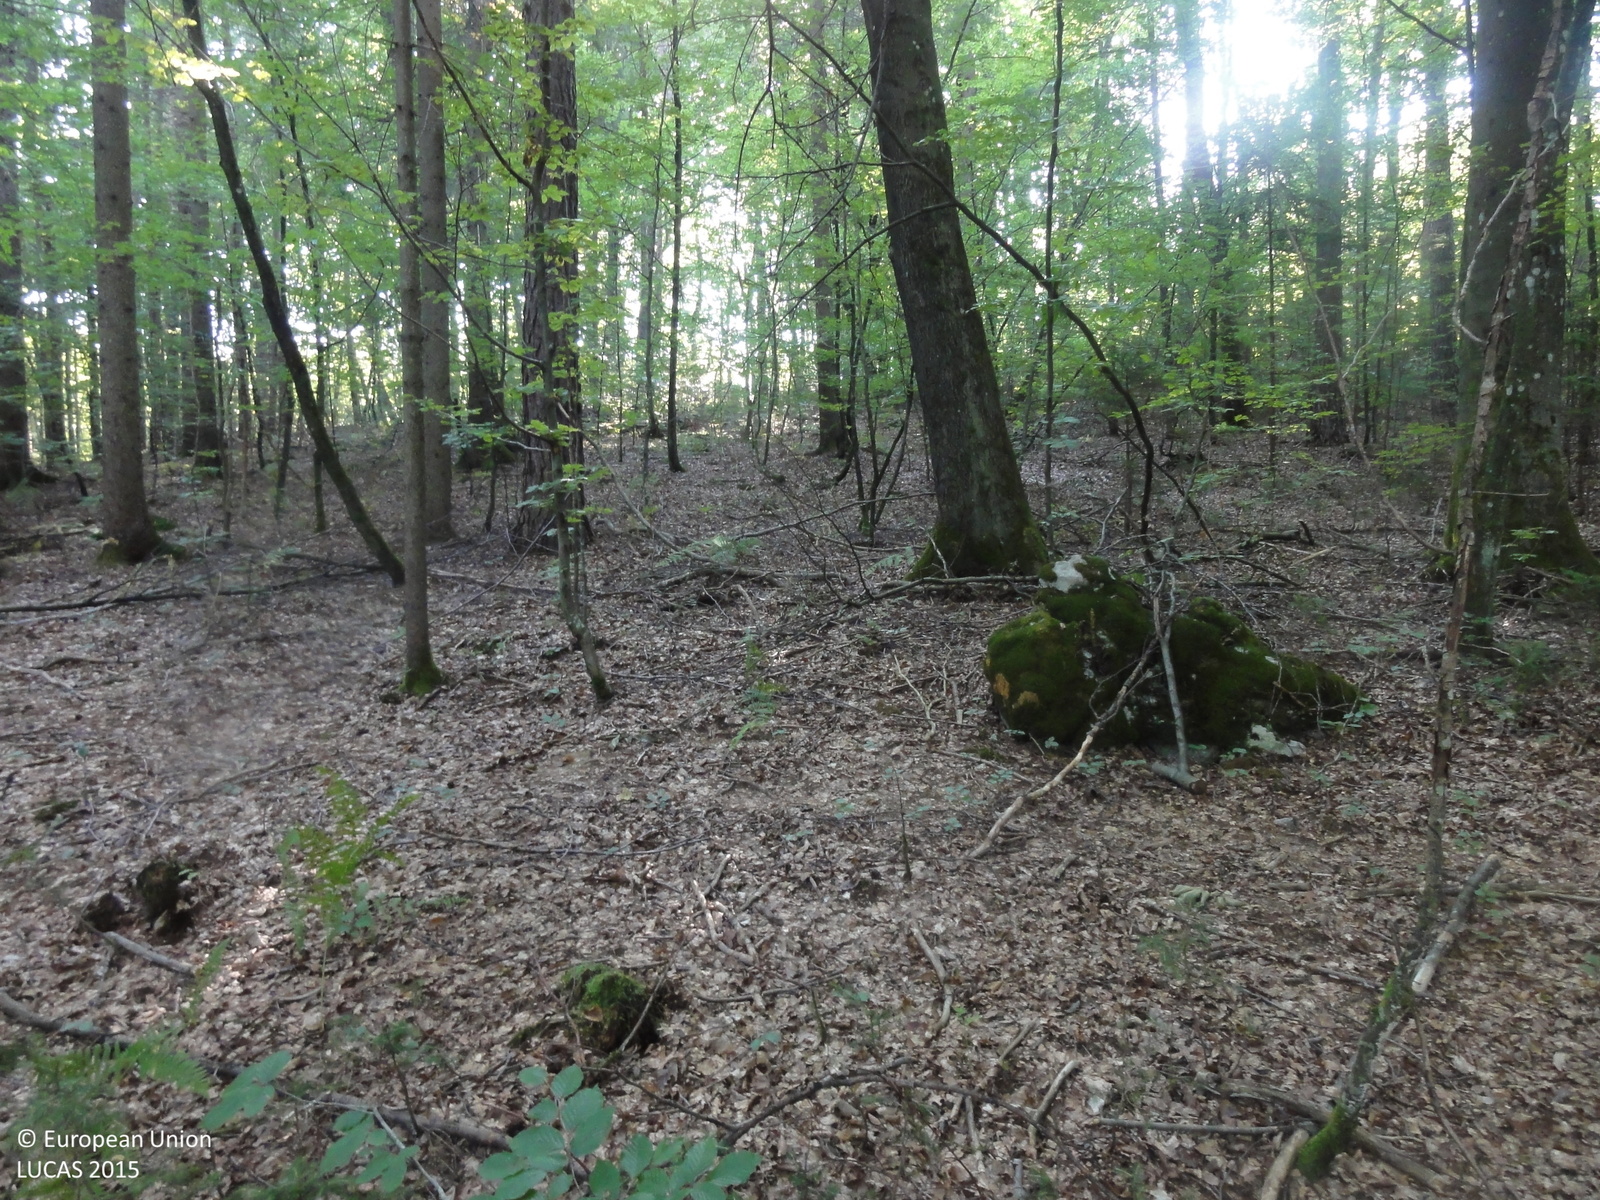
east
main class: Woodland
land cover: Spruce dominated mixed woodland
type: mountainous beech forest
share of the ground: > 75 %
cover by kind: broadleaved forest trees 60 %, coniferous forest trees 40 %
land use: Forestry
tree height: > 5 m
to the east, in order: Spruce dominated mixed woodland; Tracks; Spruce dominated mixed woodland
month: August
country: SI
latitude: 45.9269
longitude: 15.0130
